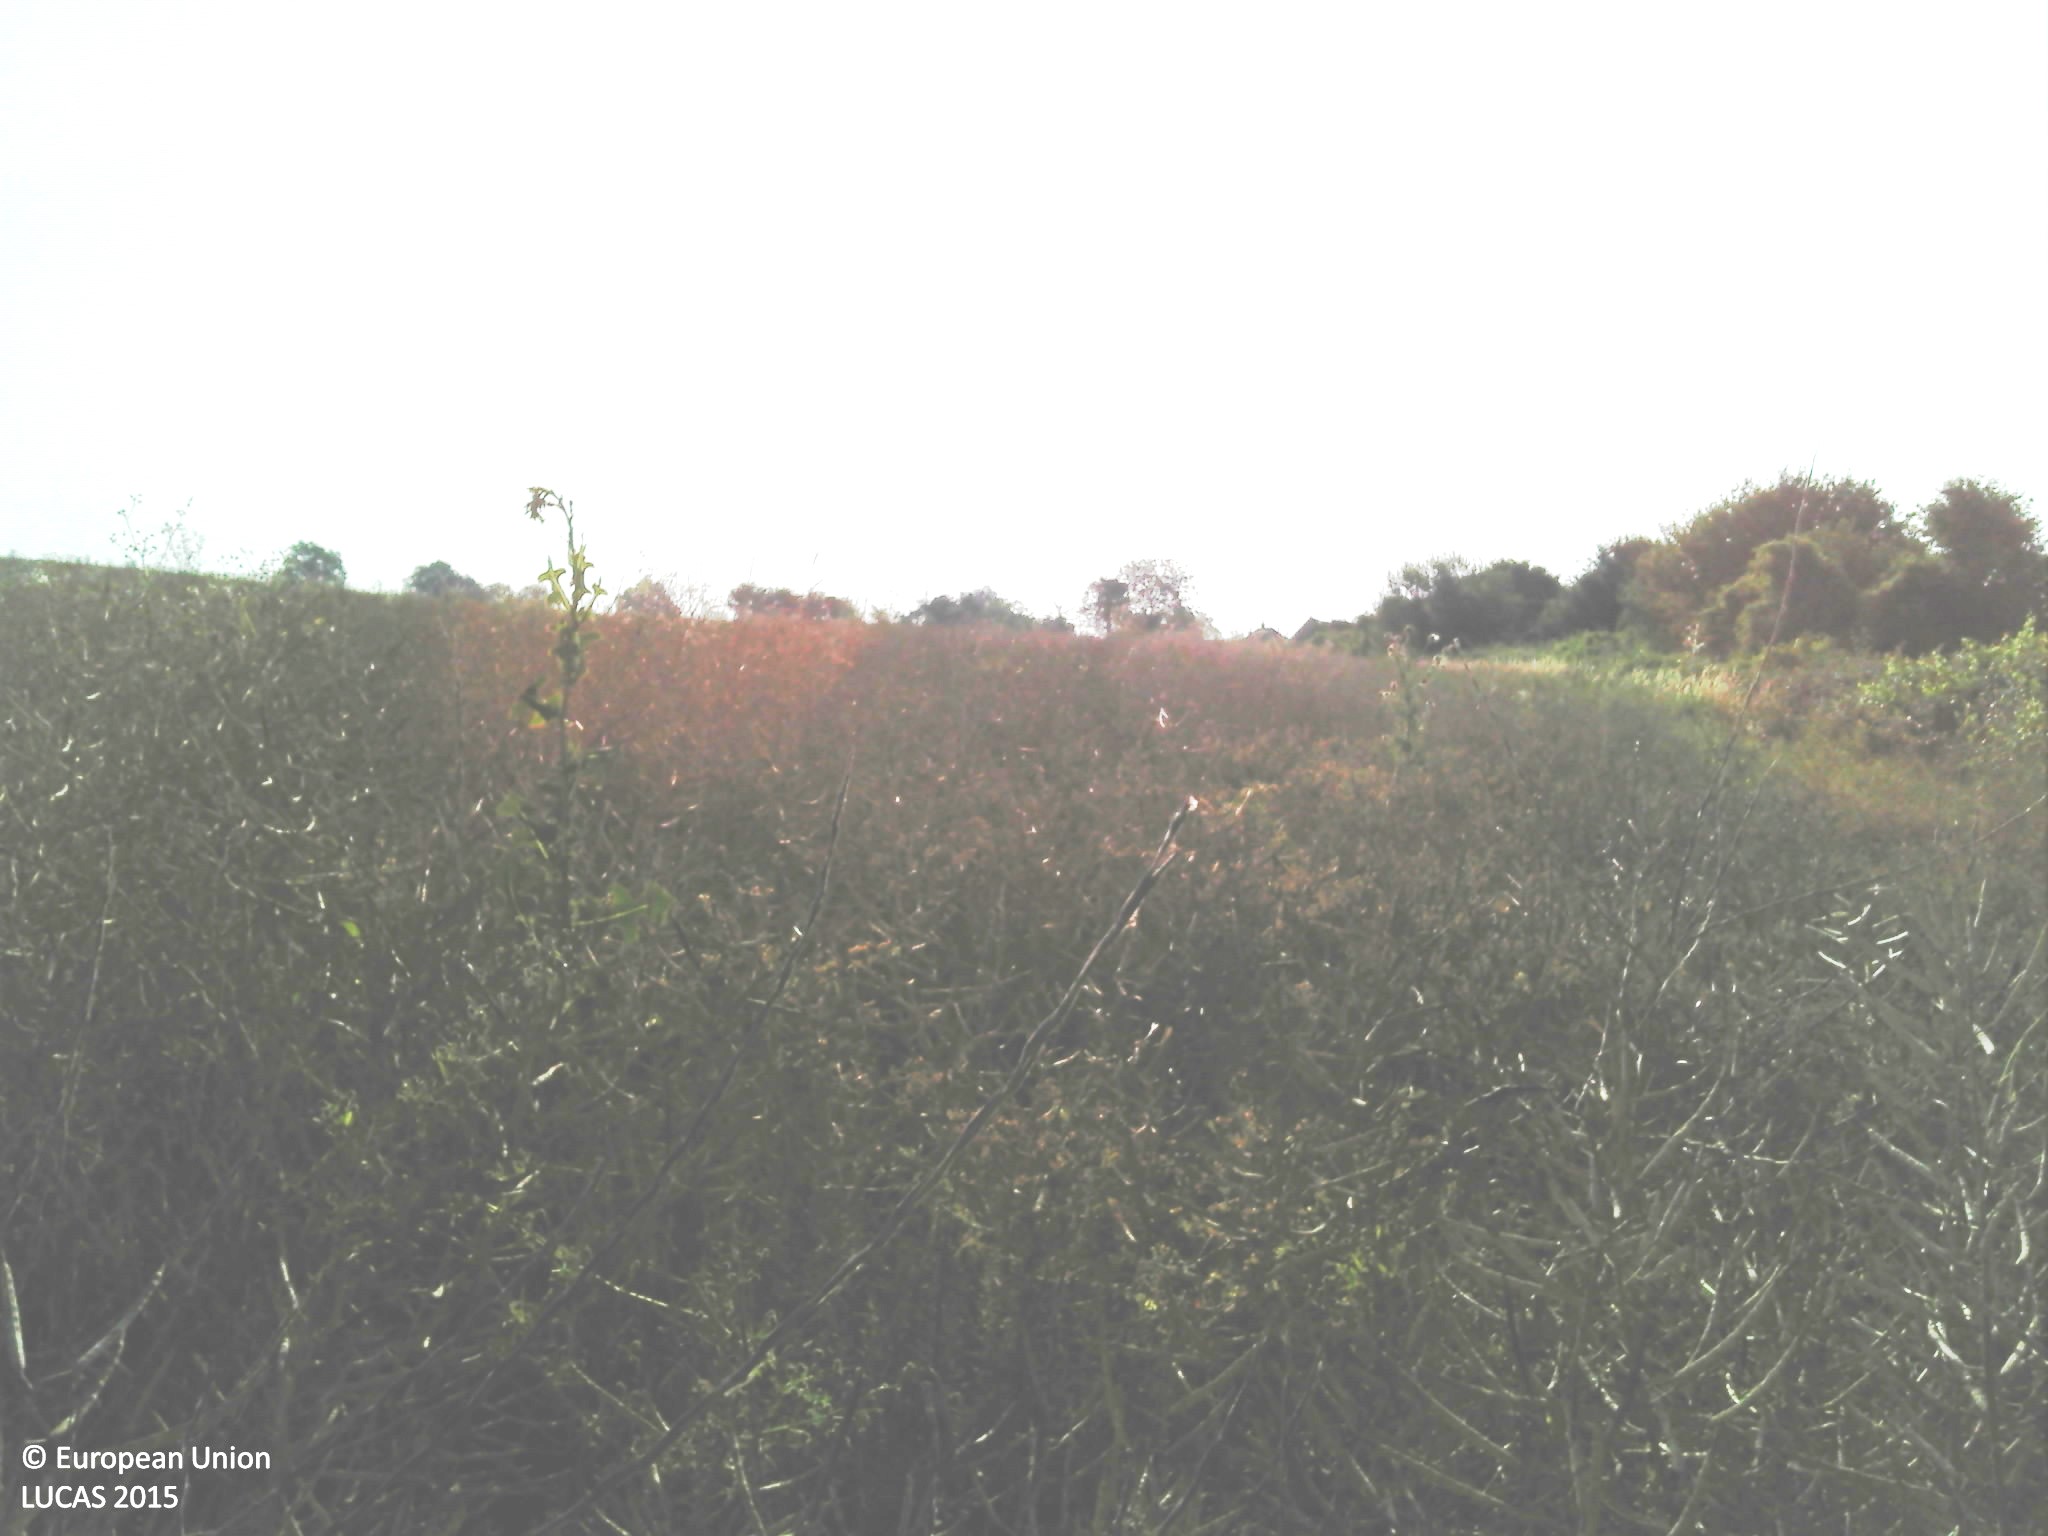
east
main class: Cropland
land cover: Rape and turnip rape
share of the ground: > 75 %
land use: Agriculture (excluding fallow land and kitchen gardens)
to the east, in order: Rape and turnip rape
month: July
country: FR
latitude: 47.0633
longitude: 3.6119
